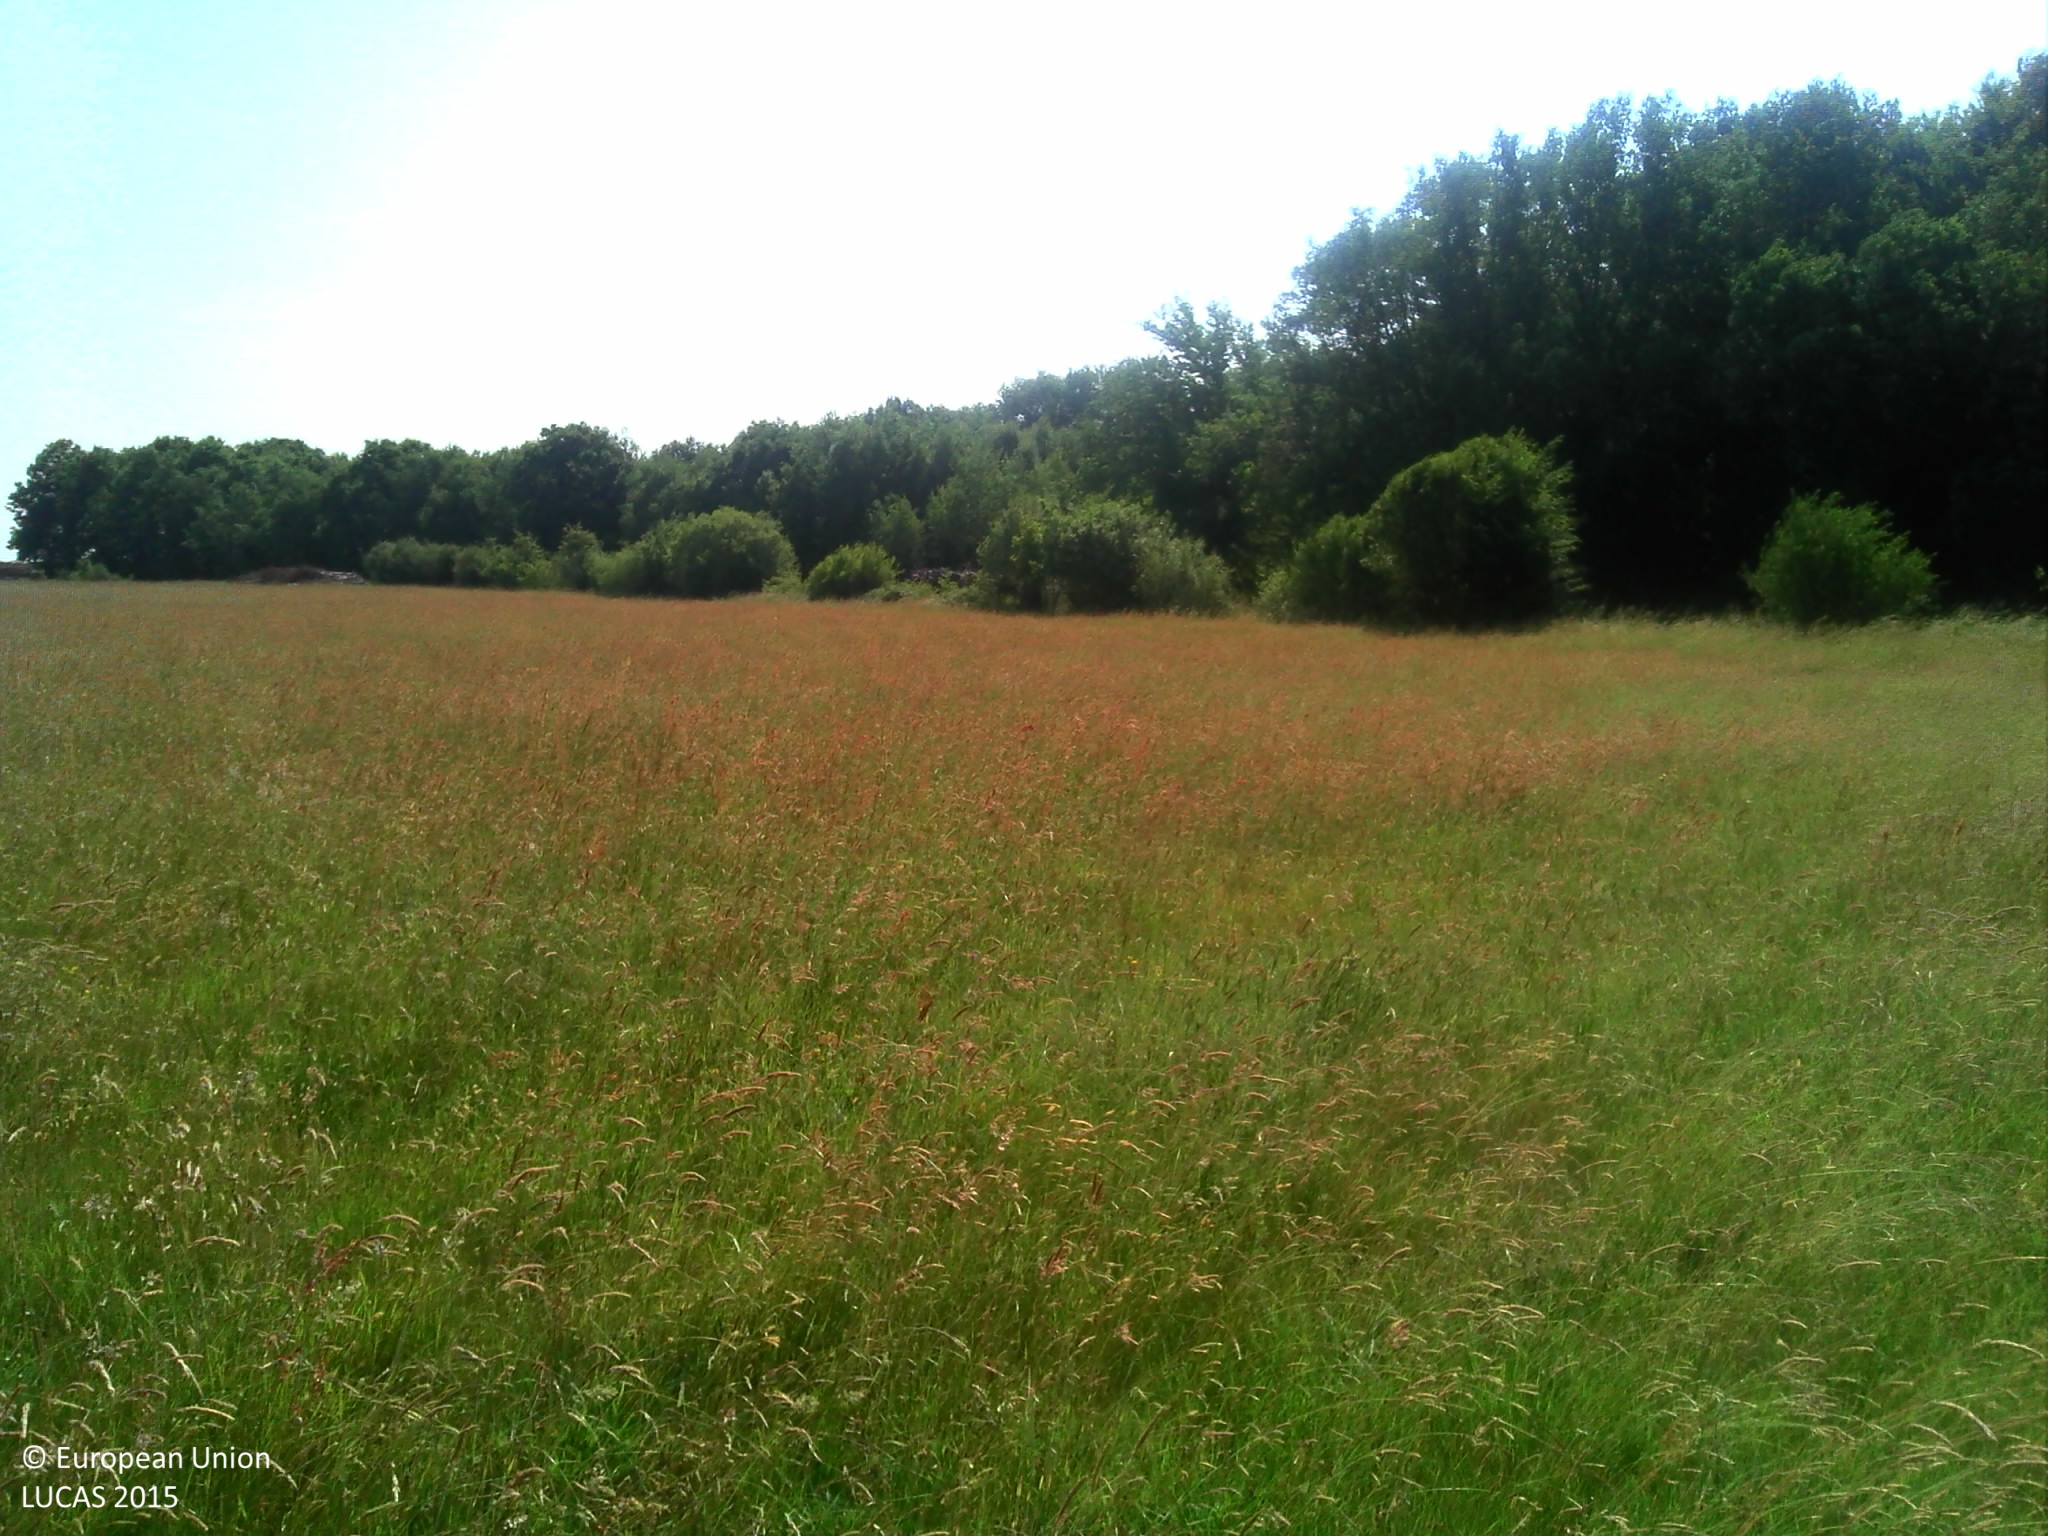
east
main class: Grassland
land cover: Grassland without tree/shrub cover
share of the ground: > 75 %
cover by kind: herbaceous plants 100 %
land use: Agriculture (excluding fallow land and kitchen gardens)
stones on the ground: < 10 %
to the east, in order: Grassland without tree/shrub cover; Fences; Managed hedges; Electric lines; Ditches and canals; Grass margins; Paved roads, cycling and walking lanes; Grass margins; Ditches and canals; Broadleaved woodland; Grass margins; Tracks; Grass margins; Broadleaved woodland; Ditches and canals; Tracks; Ditches and canals
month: June
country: FR
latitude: 47.4991
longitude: 1.5302
